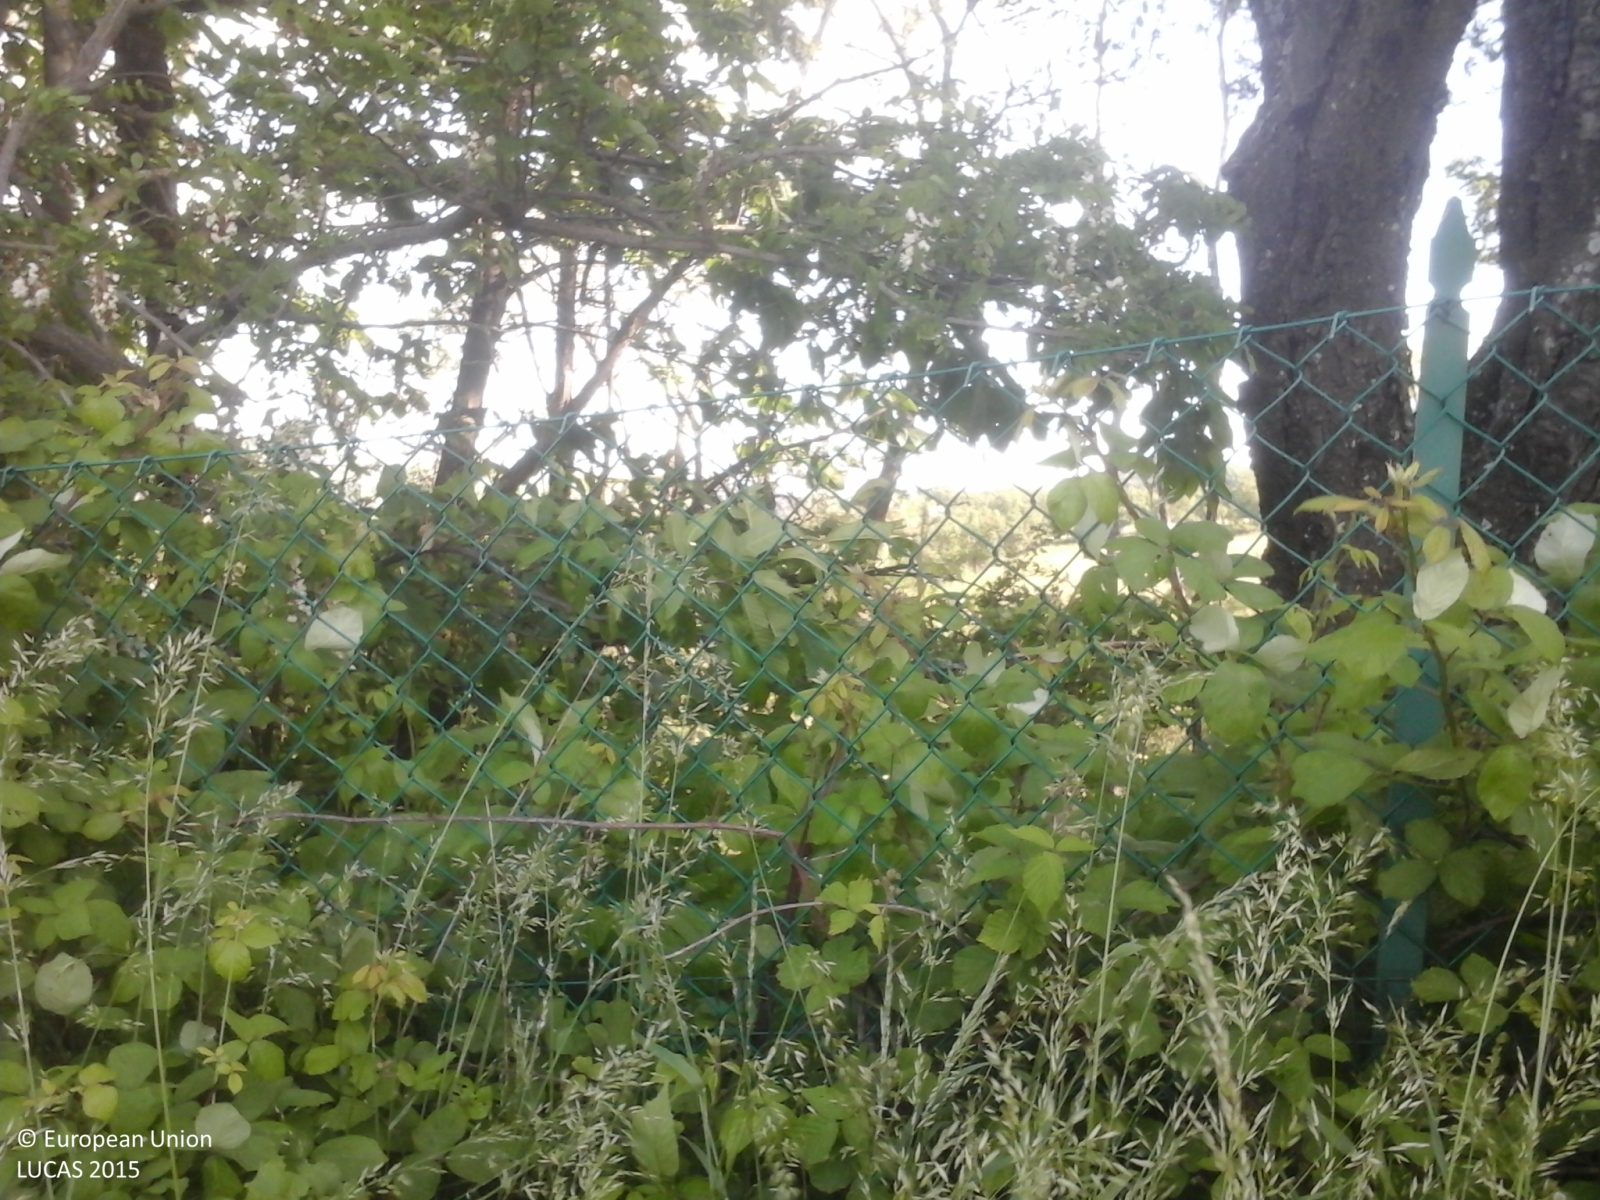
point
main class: Woodland
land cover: Broadleaved woodland
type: thermophilous deciduous forest
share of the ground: > 75 %
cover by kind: broadleaved forest trees 90 %, shrubs 10 %
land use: Forestry
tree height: > 5 m
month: May
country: IT
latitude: 44.3451
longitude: 11.0638
